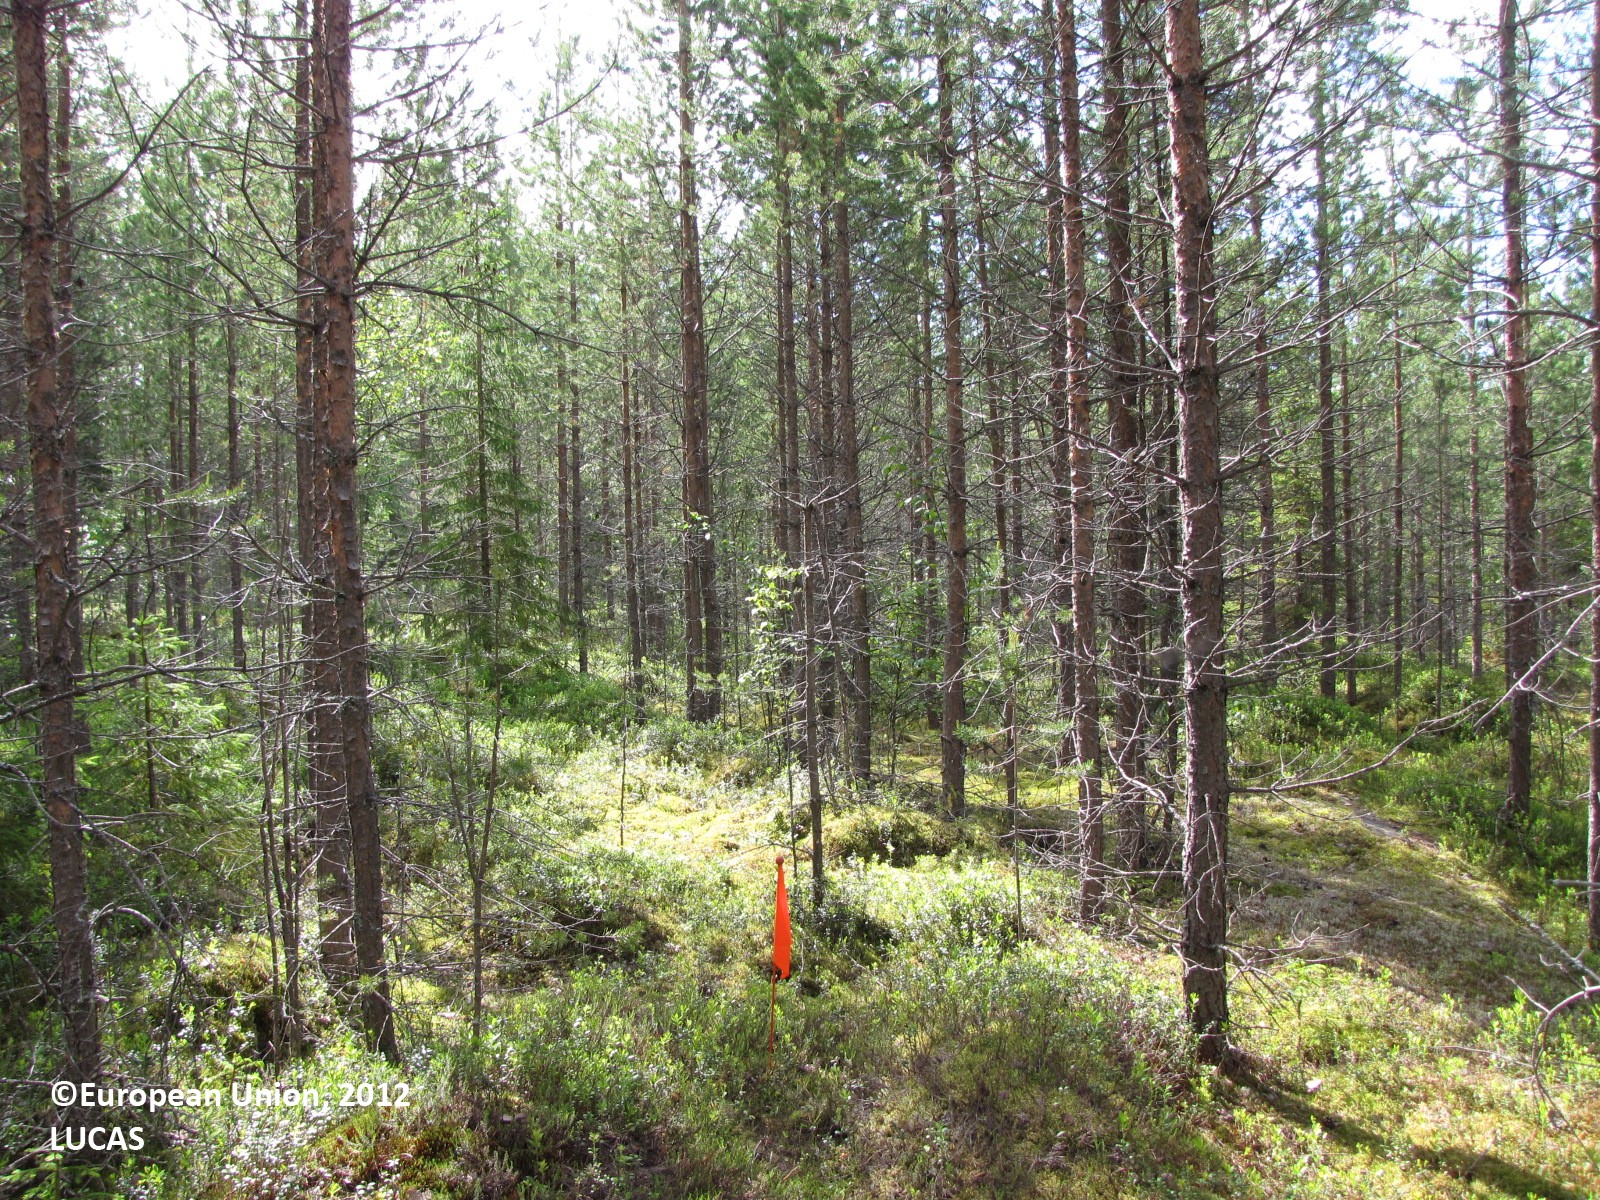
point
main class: Woodland
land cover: Pine dominated coniferous woodland
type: boreal forest
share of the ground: 50 - 75 %
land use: Forestry
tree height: > 5 m
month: July
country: FI
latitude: 66.1342
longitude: 25.2360
